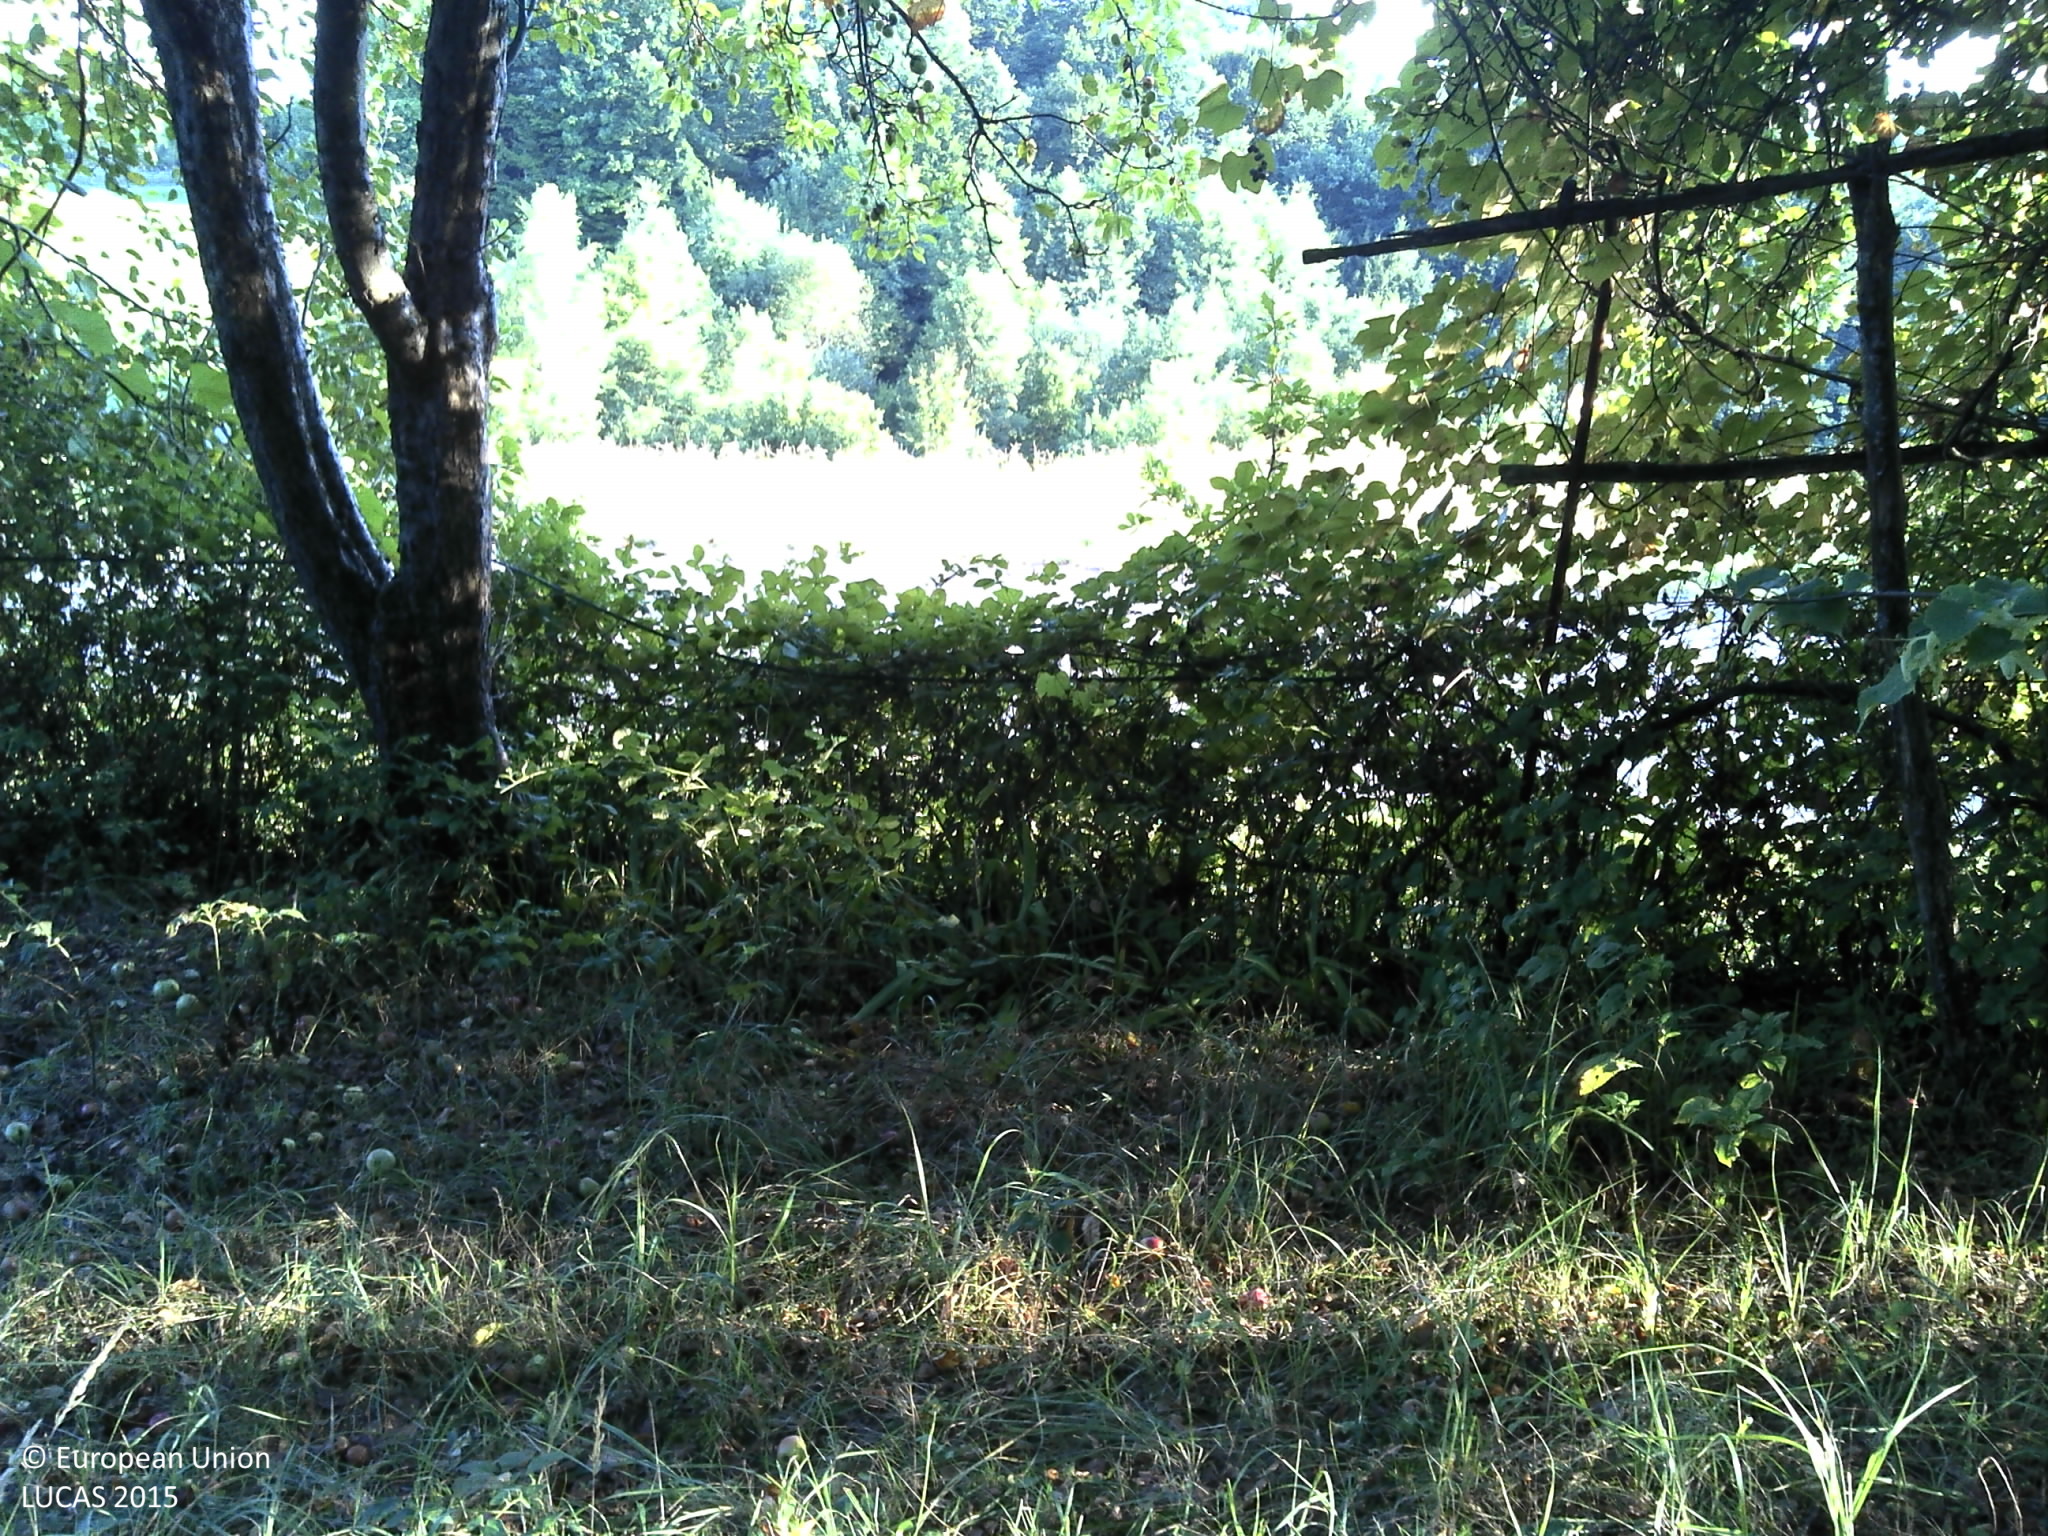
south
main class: Woodland
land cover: Broadleaved woodland
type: beech forest
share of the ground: > 75 %
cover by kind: broadleaved forest trees 100 %
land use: Forestry
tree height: > 5 m
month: August
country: HR
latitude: 45.3571
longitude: 15.9068
